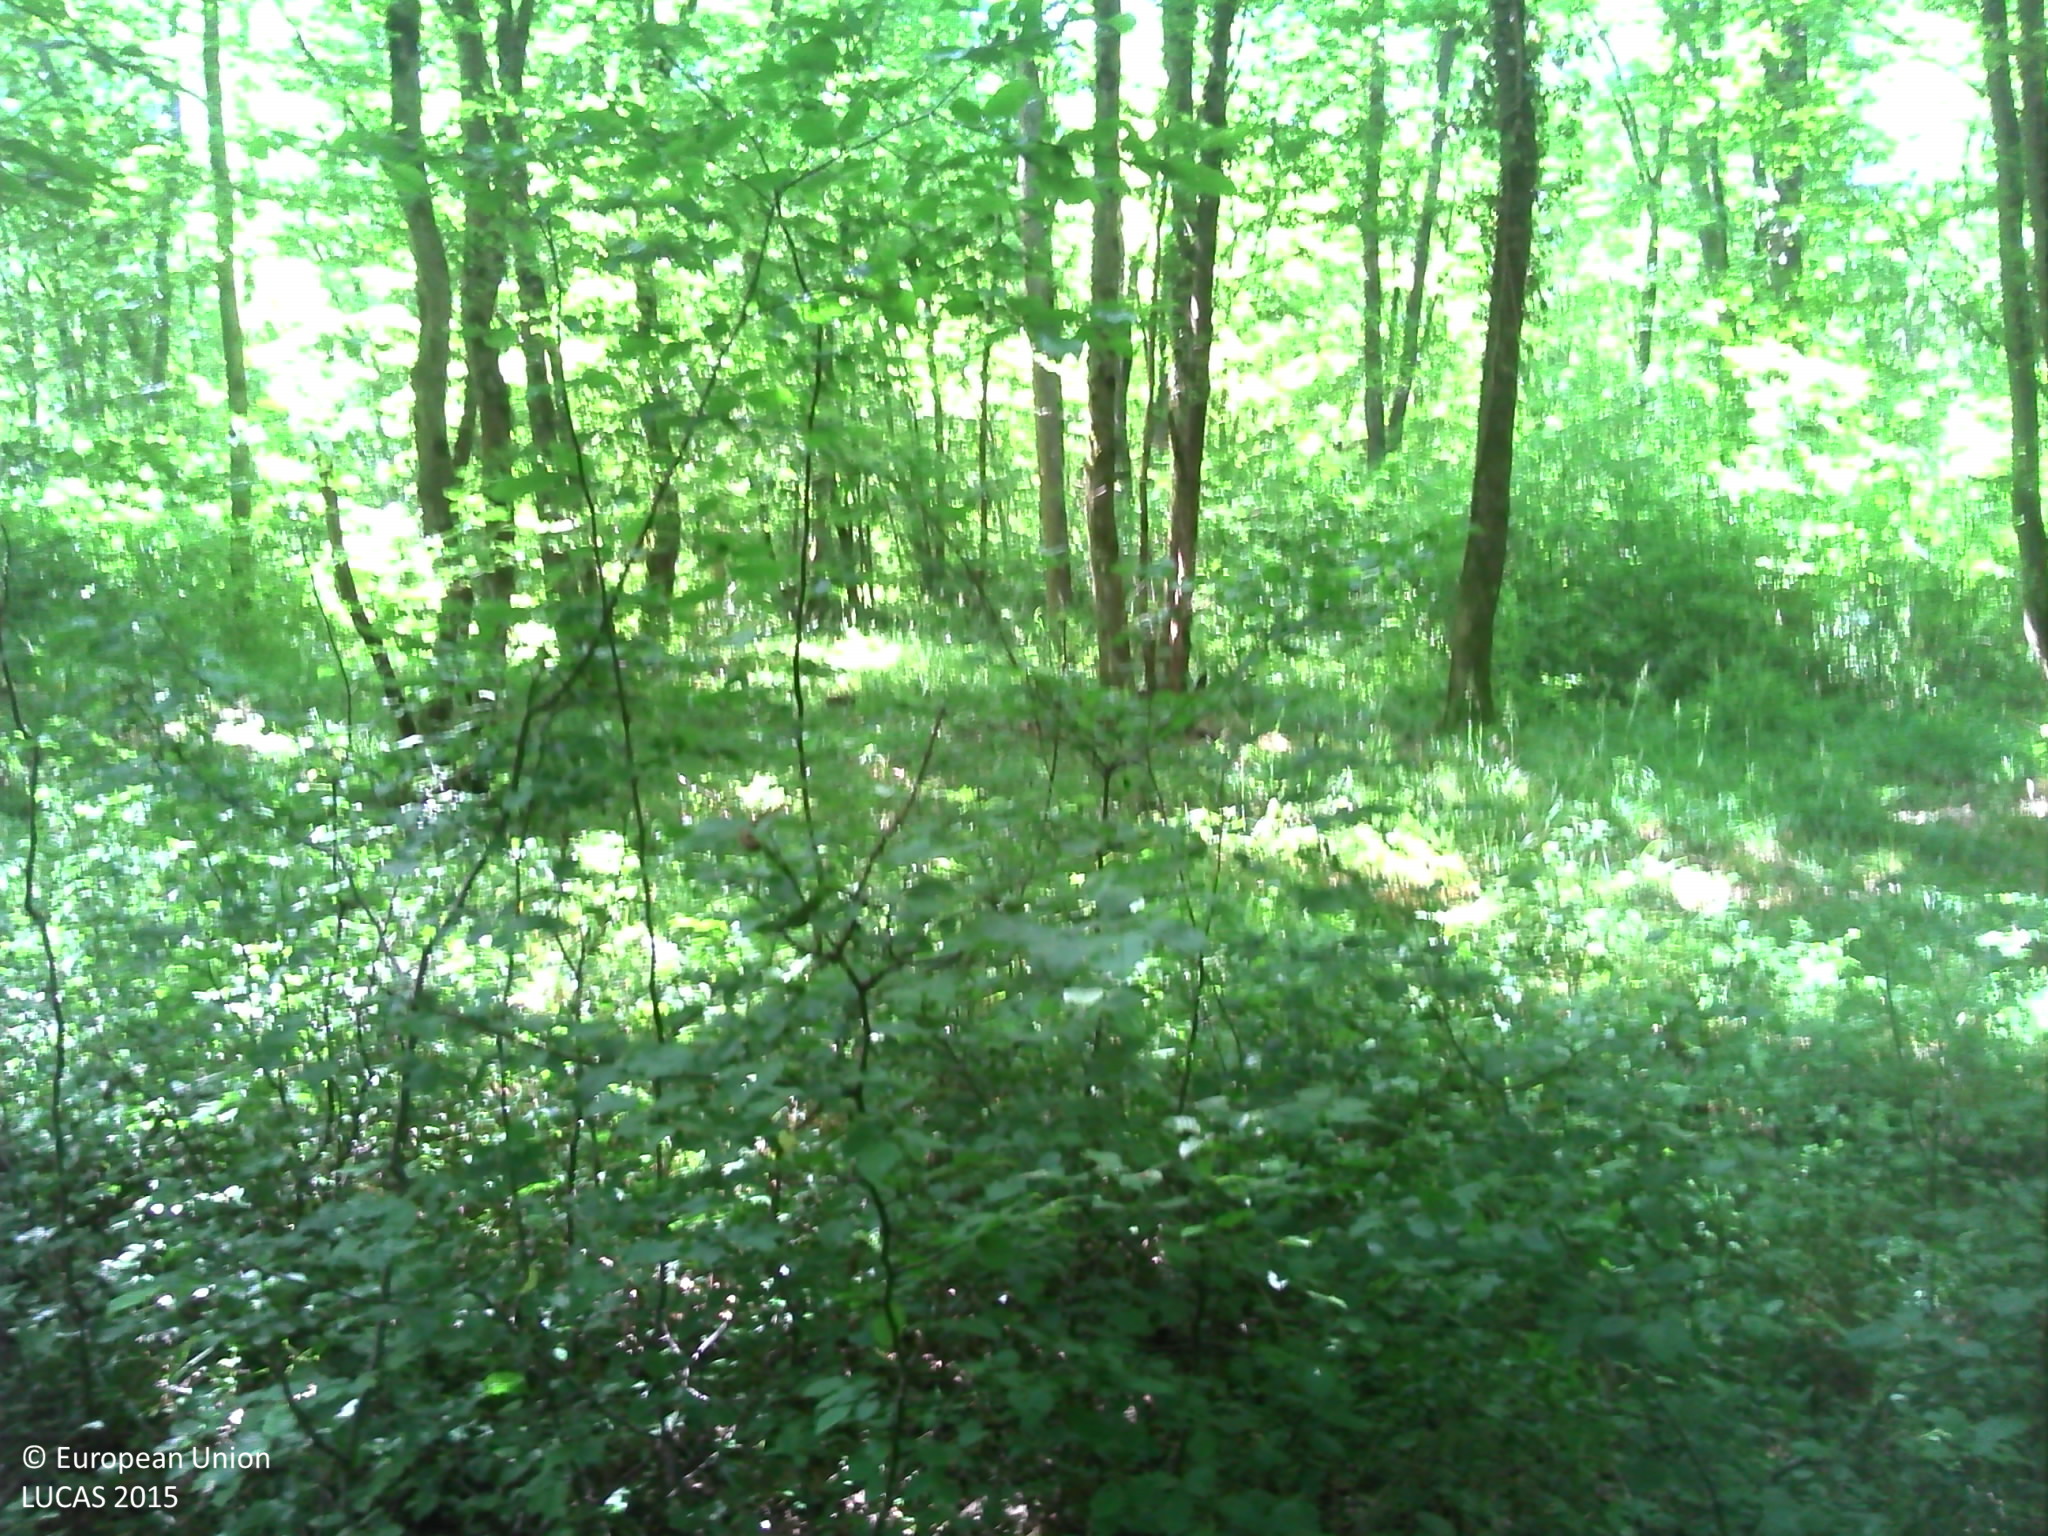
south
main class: Woodland
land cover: Broadleaved woodland
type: mesophytic deciduous forest
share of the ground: > 75 %
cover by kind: broadleaved forest trees 95 %, herbaceous plants 5 %
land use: Forestry
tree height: > 5 m
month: June
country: FR
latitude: 47.7626
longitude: 7.4799
